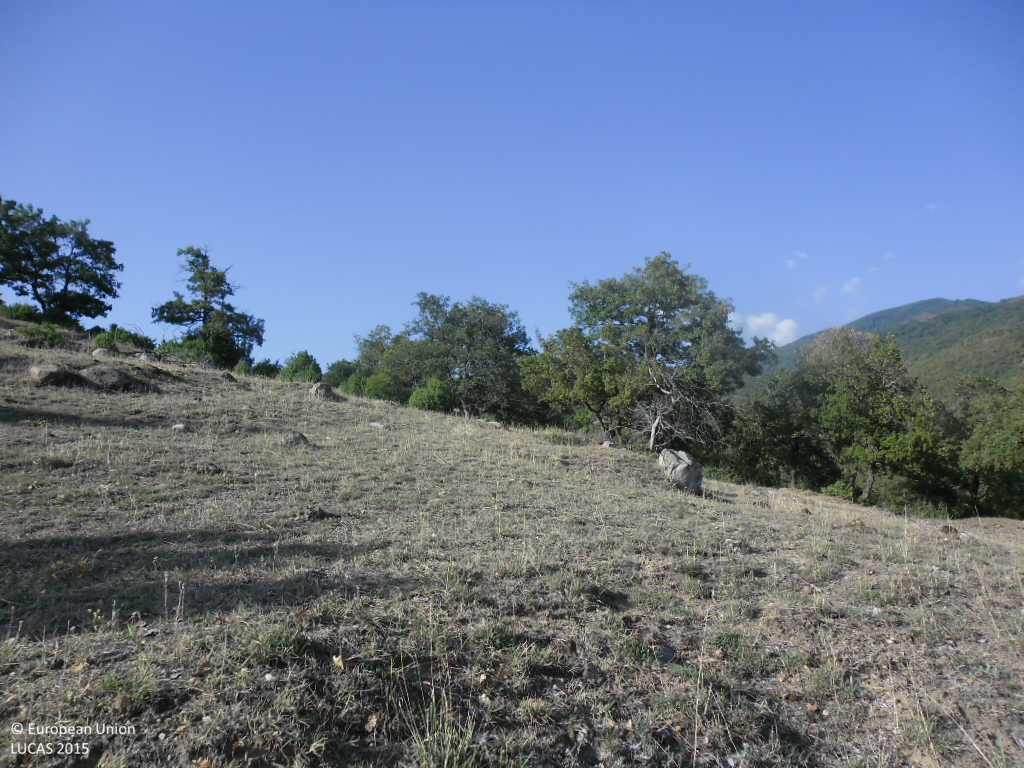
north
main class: Grassland
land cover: Grassland with sparse tree/shrub cover
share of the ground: > 75 %
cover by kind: herbaceous plants 90 %, broadleaved forest trees 5 %, shrubs 5 %
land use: Agriculture (excluding fallow land and kitchen gardens)
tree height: < 5 m
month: September
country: BG
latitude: 41.6250
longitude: 23.3098
